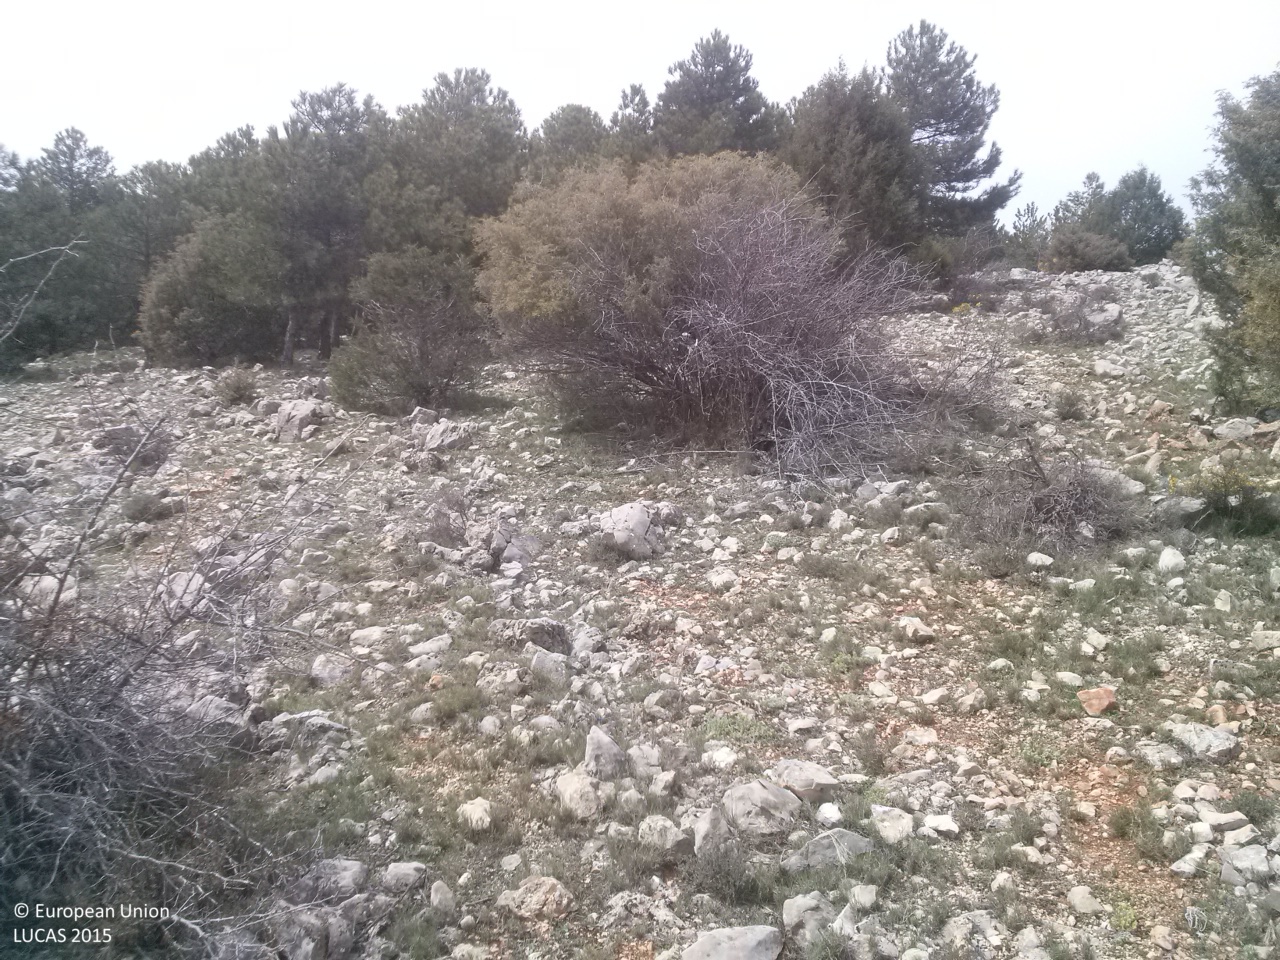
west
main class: Grassland
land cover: Grassland with sparse tree/shrub cover
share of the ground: 50 - 75 %
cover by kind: consolidated bare surface 55 %, herbaceous plants 35 %, coniferous forest trees 5 %, shrubs 5 %
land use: Semi-natural and natural areas not in use
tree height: < 5 m
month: April
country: ES
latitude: 40.0561
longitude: -1.8651
